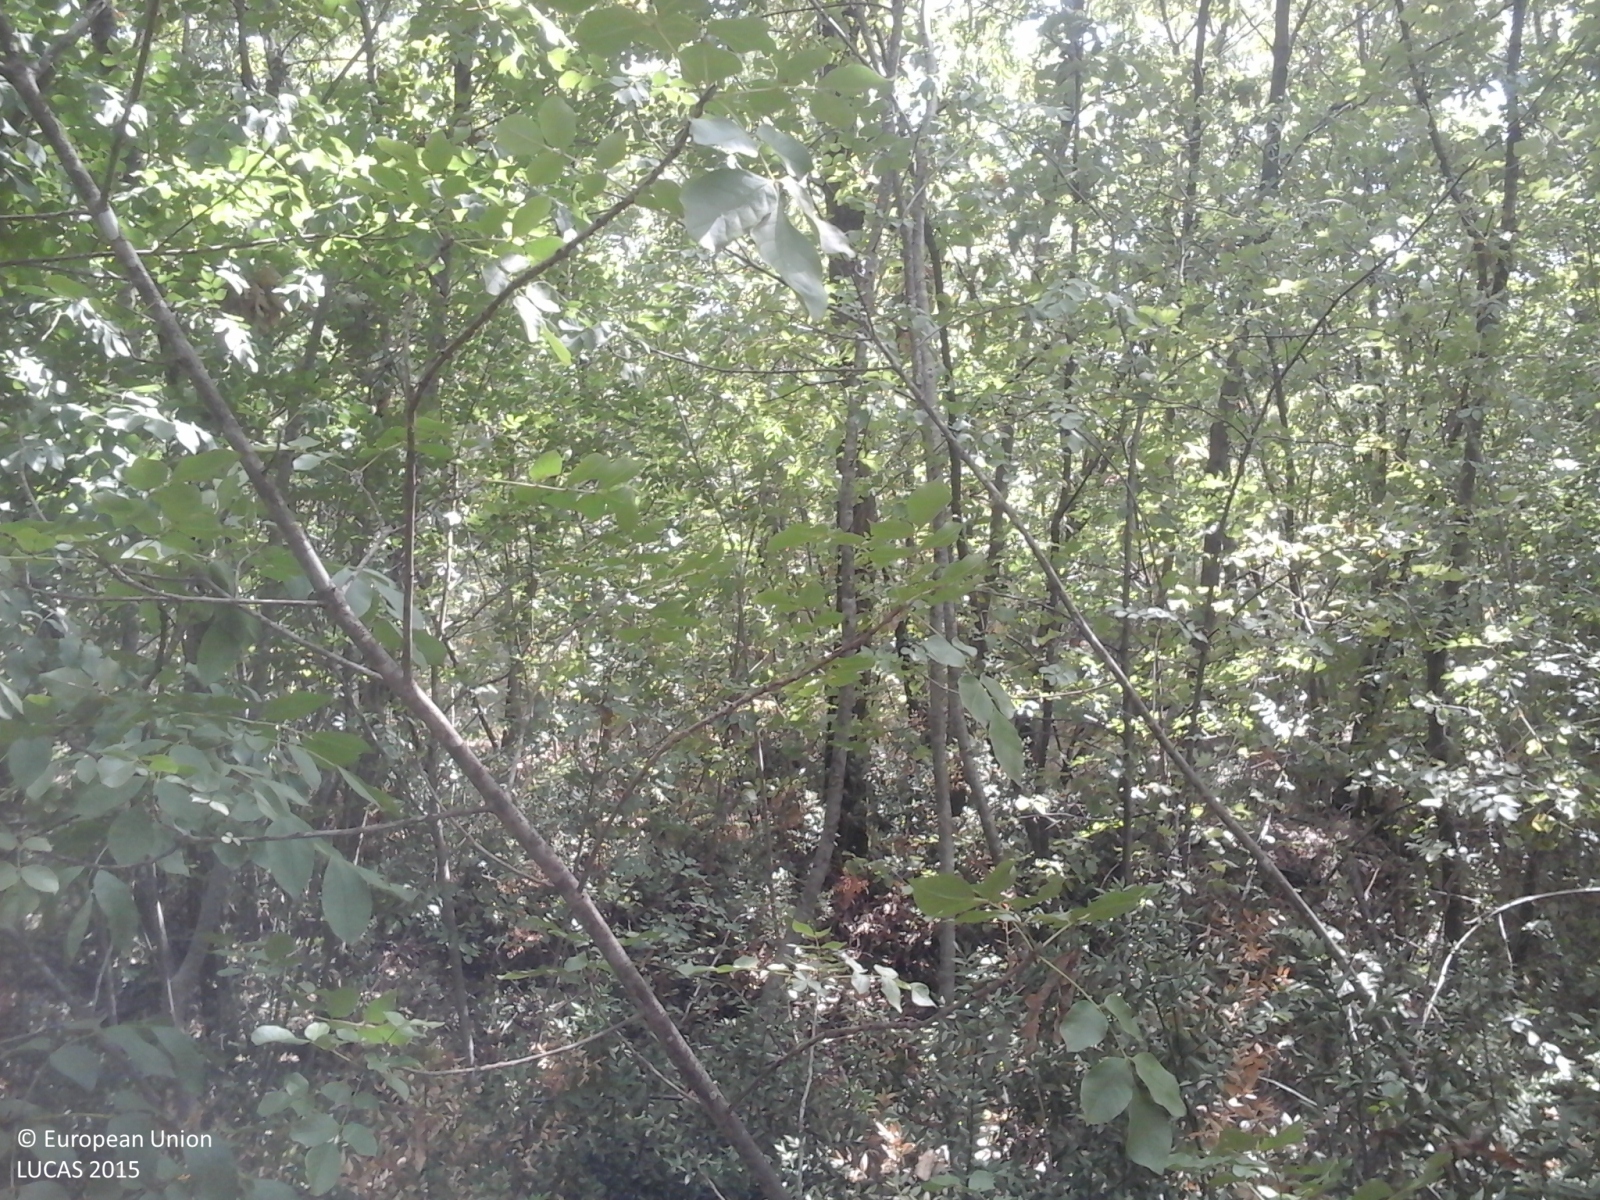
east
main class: Woodland
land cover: Broadleaved woodland
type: thermophilous deciduous forest
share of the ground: > 75 %
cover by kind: broadleaved forest trees 100 %
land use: Forestry
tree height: > 5 m
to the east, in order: Broadleaved woodland; Electric lines; Broadleaved woodland; Paved roads, cycling and walking lanes; Broadleaved woodland; Fences; Broadleaved woodland
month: August
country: IT
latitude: 43.9319
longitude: 10.8822
